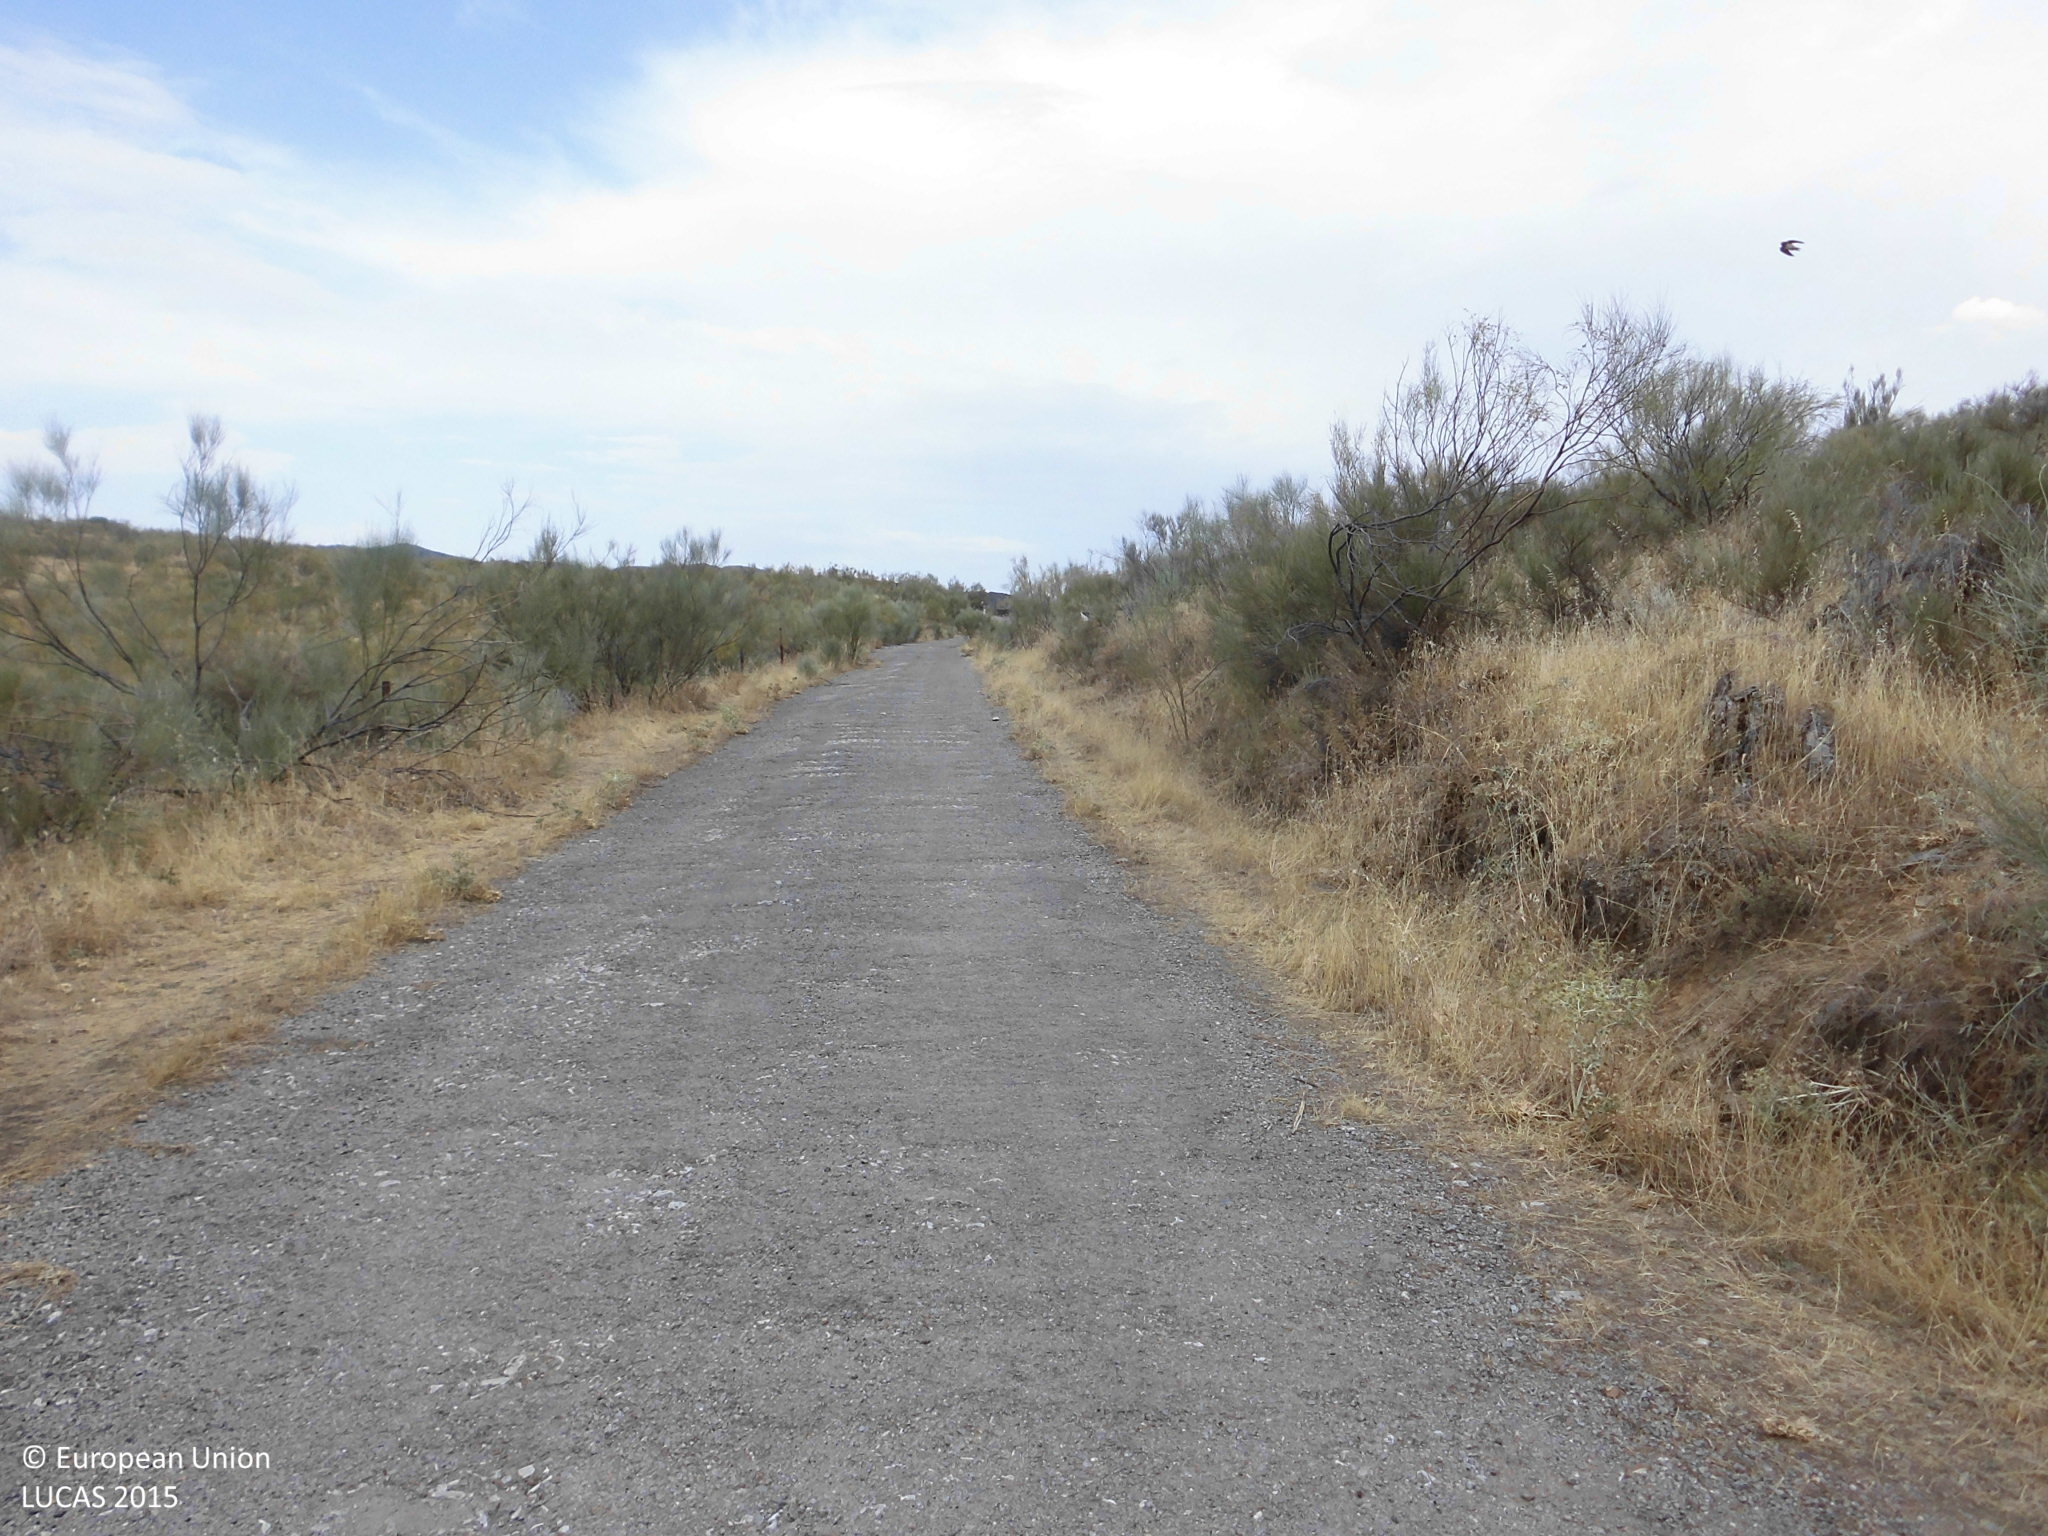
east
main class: Shrubland
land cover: Shrubland without tree cover
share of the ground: 25 - 50 %
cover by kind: shrubs 50 %, herbaceous plants 50 %
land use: Agriculture (excluding fallow land and kitchen gardens)
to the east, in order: Shrubland without tree cover; Tracks; Shrubland without tree cover; Tracks; Shrubland without tree cover
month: July
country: ES
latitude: 39.7581
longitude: -5.6410
